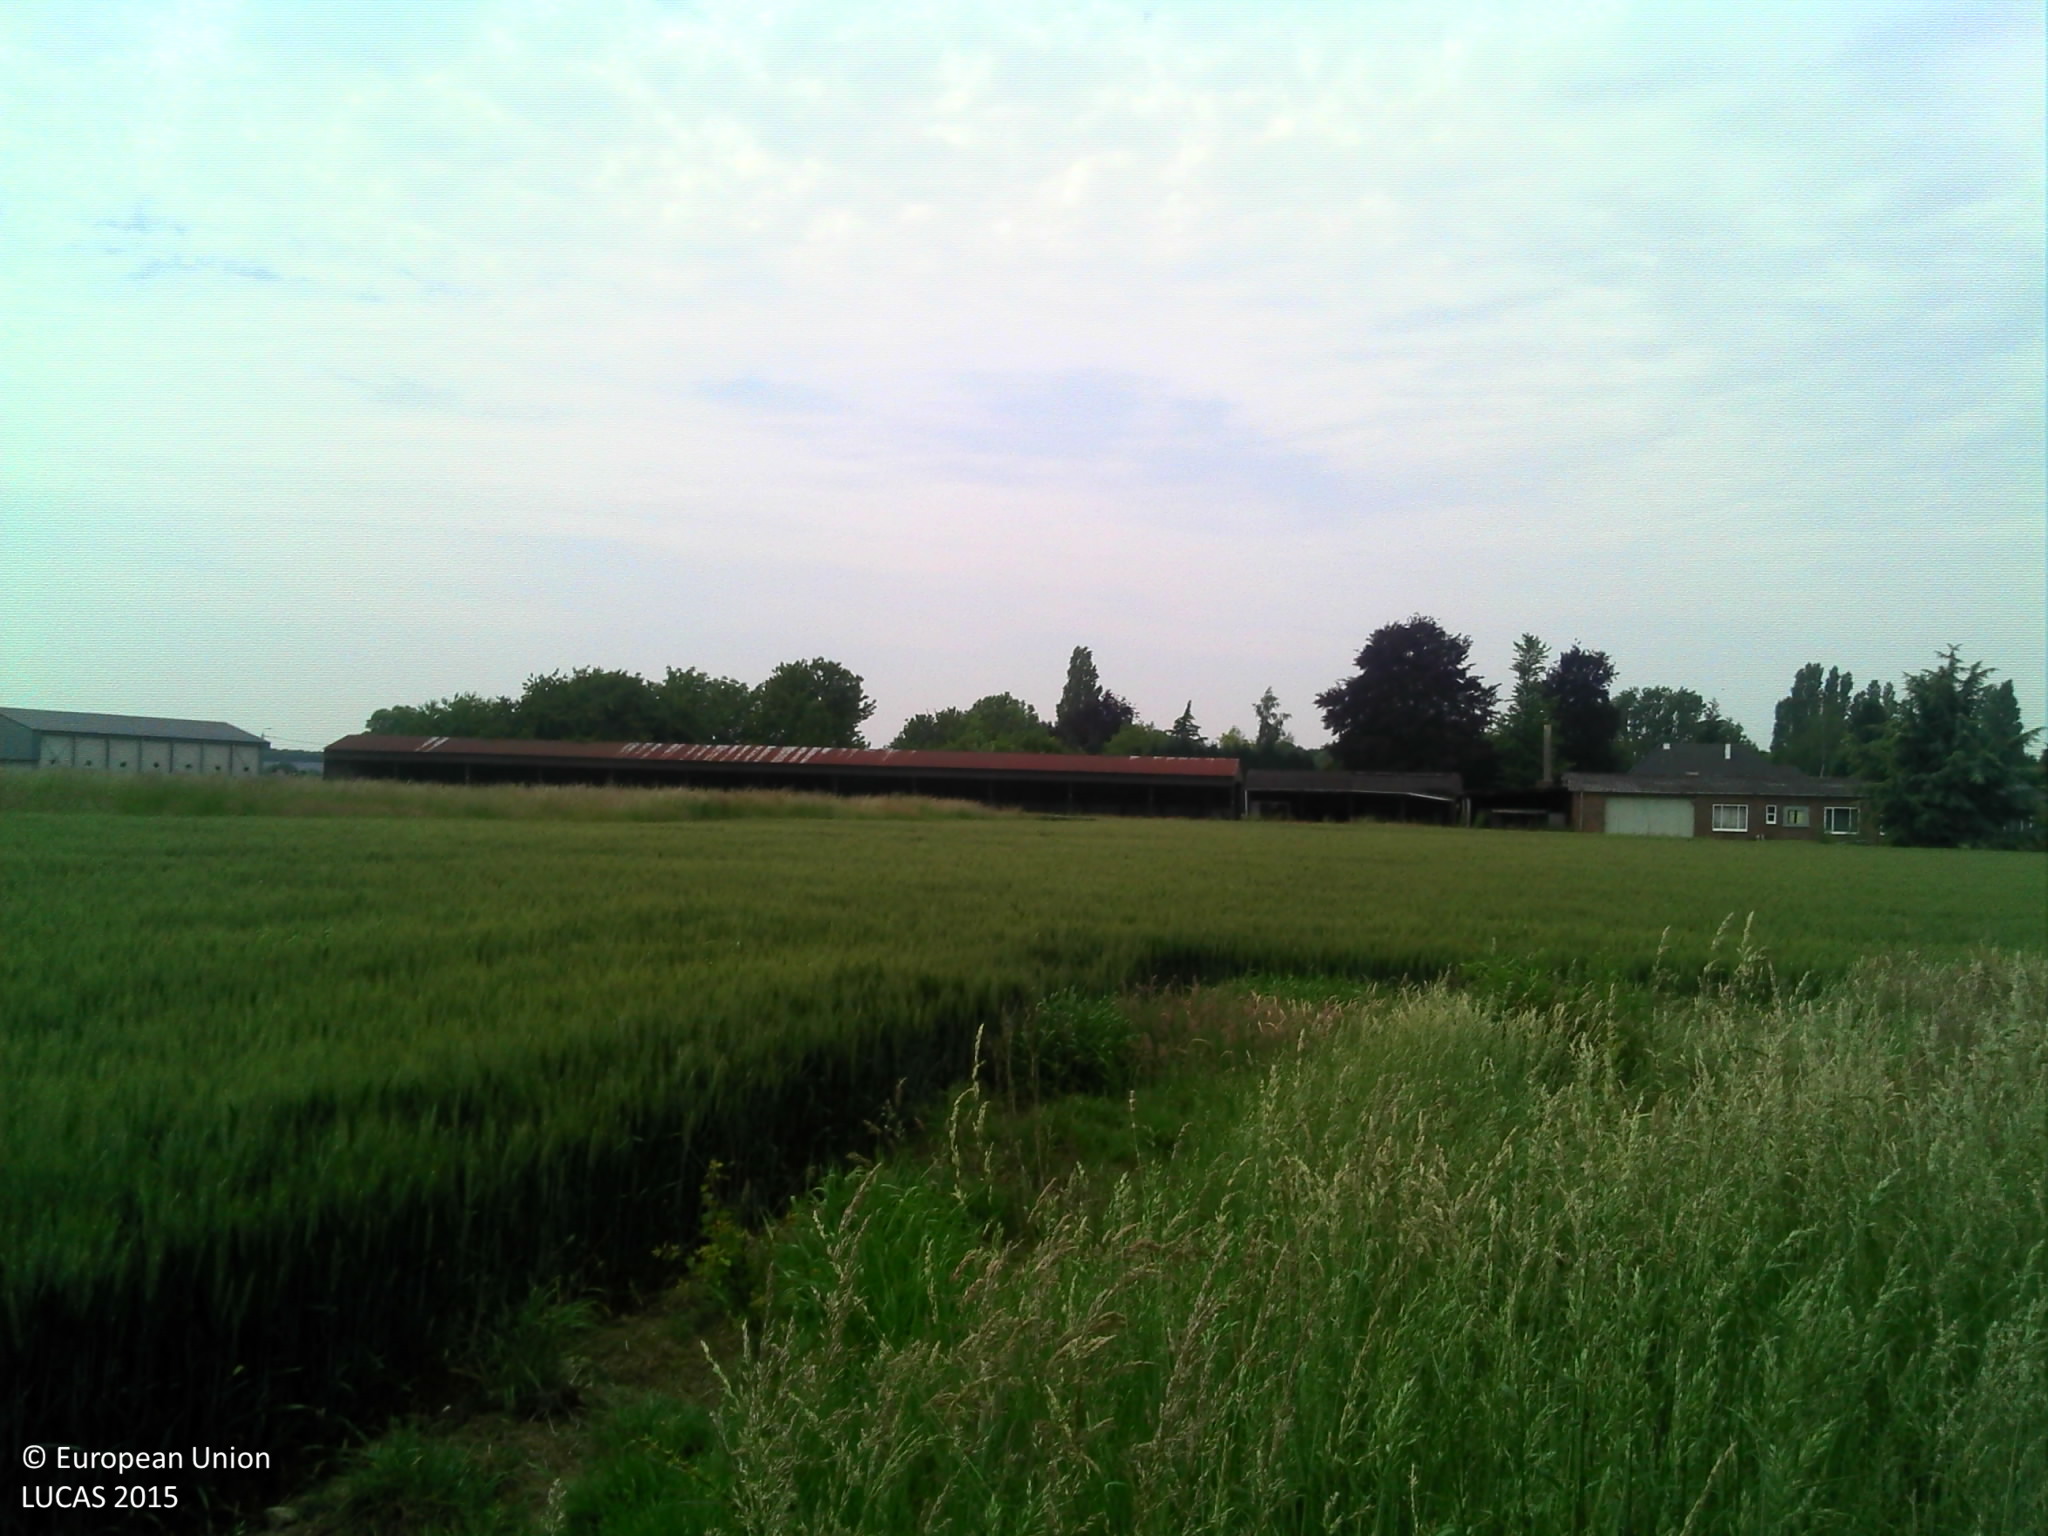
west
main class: Grassland
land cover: Grassland without tree/shrub cover
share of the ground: > 75 %
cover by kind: herbaceous plants 95 %, shrubs 5 %
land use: Agriculture (excluding fallow land and kitchen gardens)
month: June
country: BE
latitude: 50.8817
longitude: 4.5236
